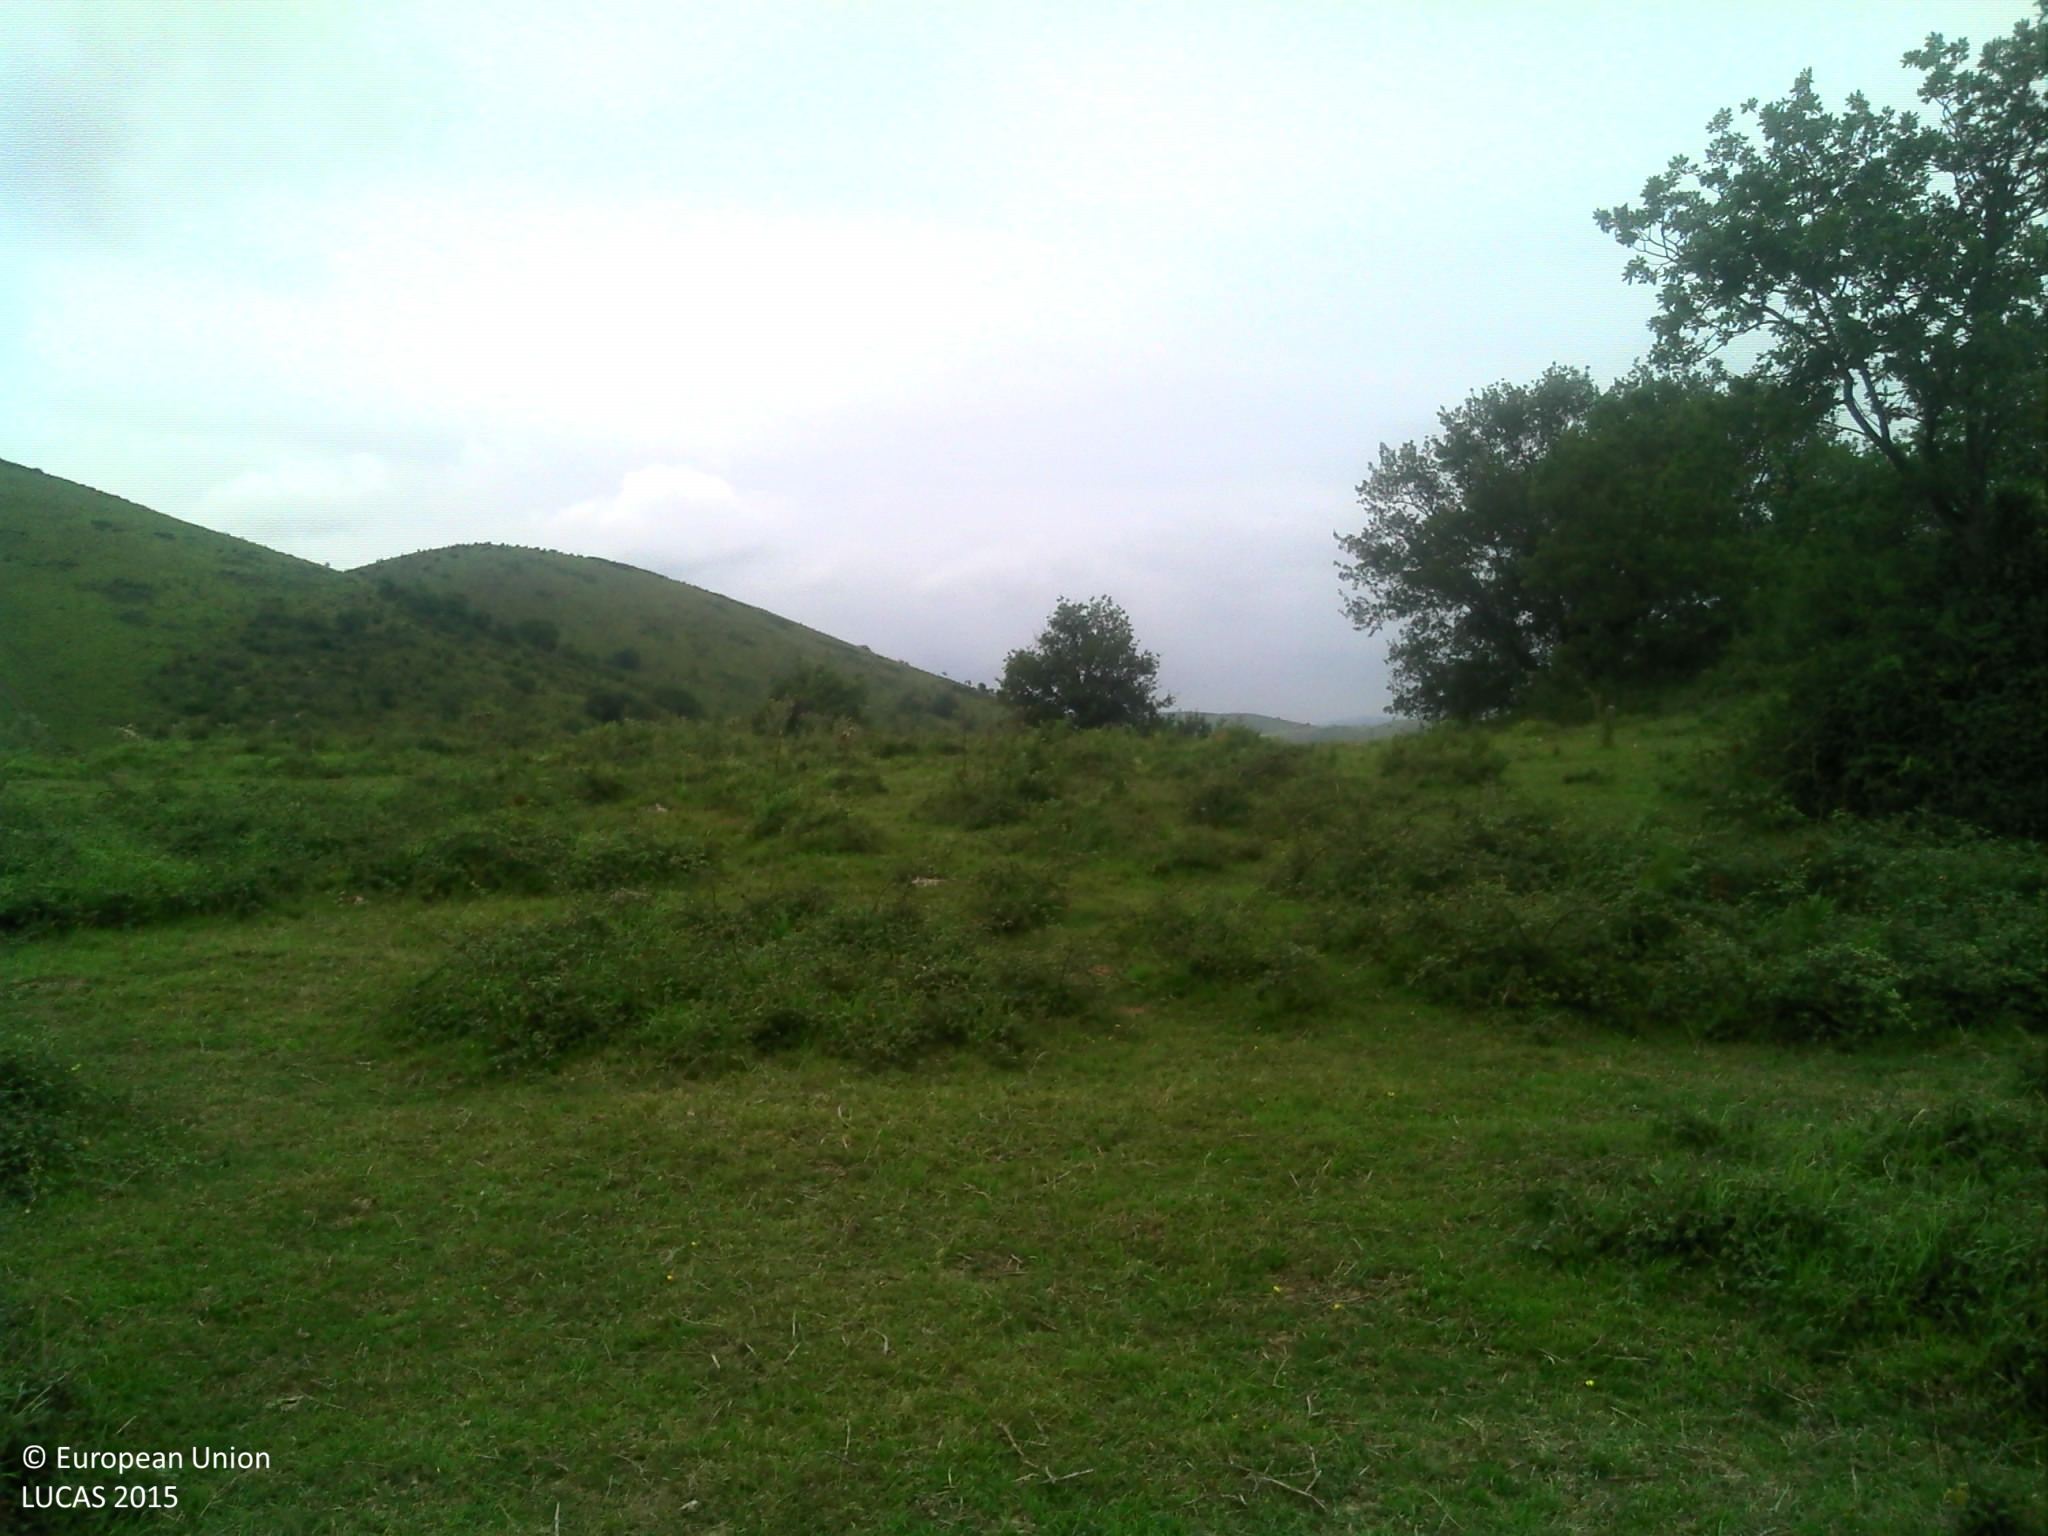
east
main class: Grassland
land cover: Grassland without tree/shrub cover
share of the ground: > 75 %
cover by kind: herbaceous plants 95 %, shrubs 5 %
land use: Agriculture (excluding fallow land and kitchen gardens)
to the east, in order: Grassland without tree/shrub cover; Grassland with sparse tree/shrub cover; Grassland without tree/shrub cover
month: August
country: FR
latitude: 43.2552
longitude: -1.1610
